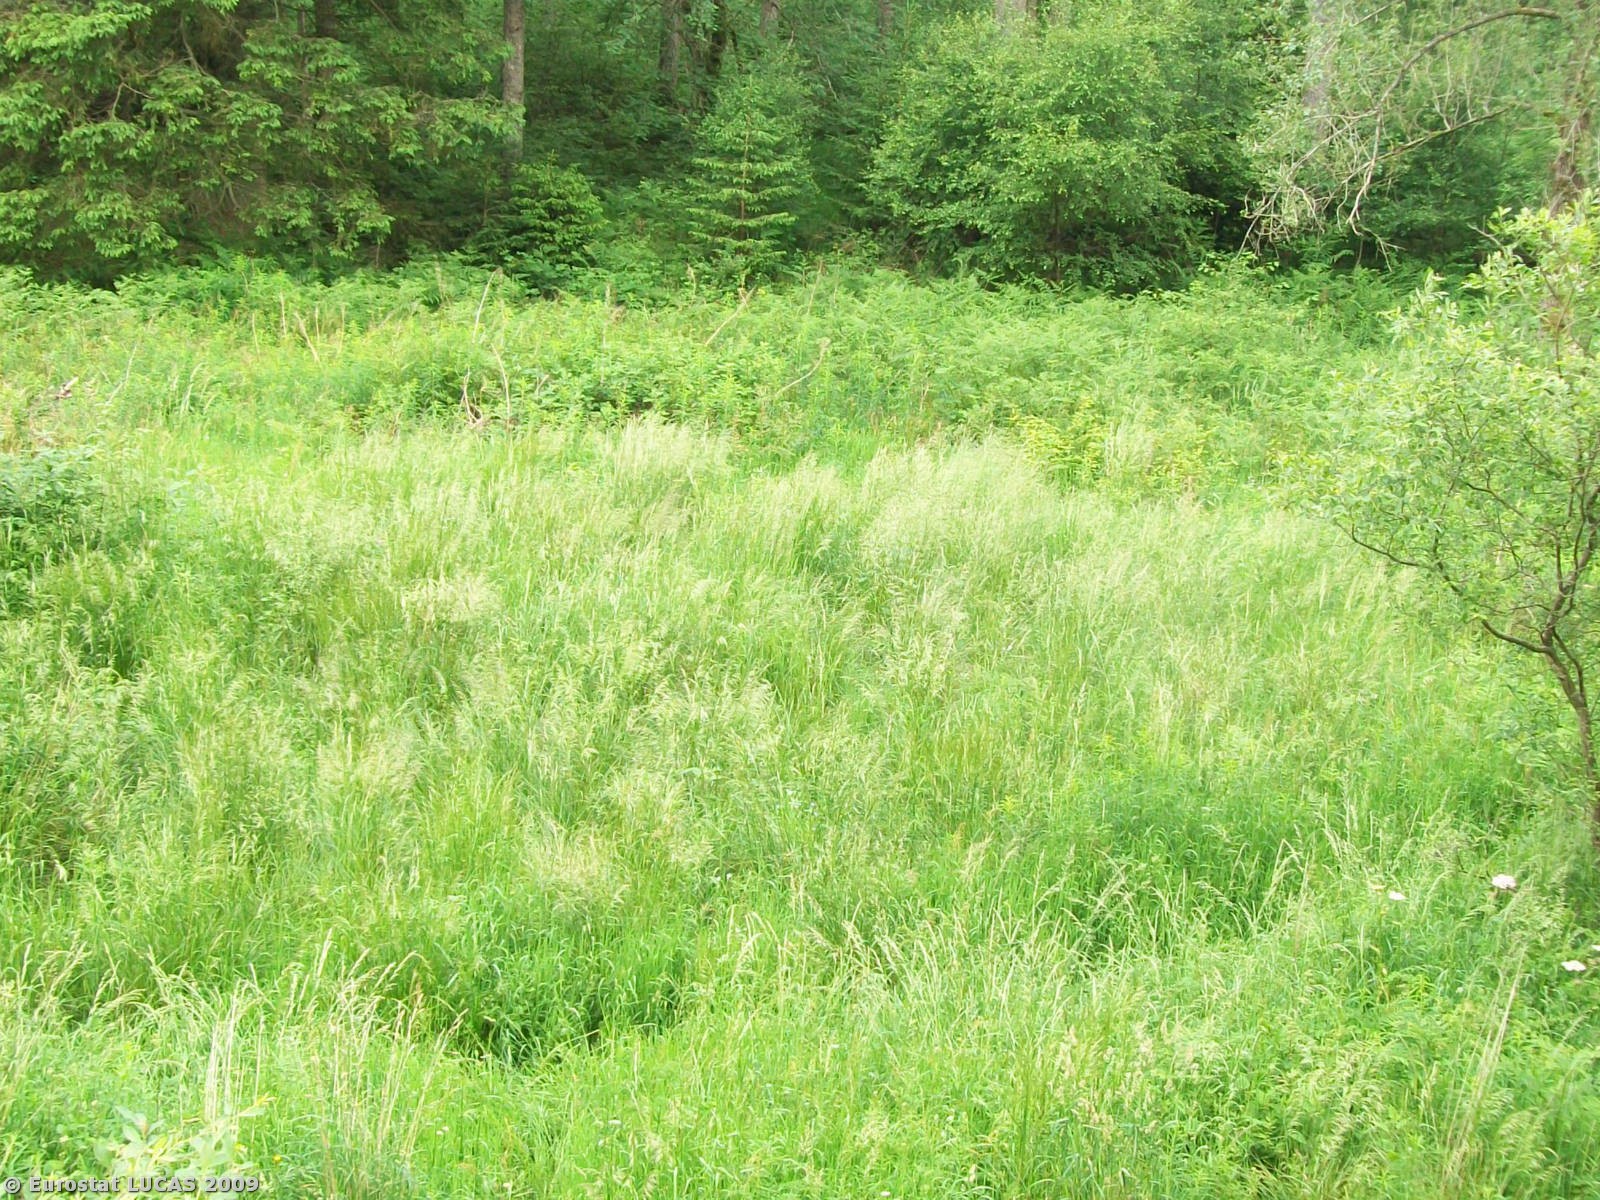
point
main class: Grassland
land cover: Grassland with sparse tree/shrub cover
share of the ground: 50 - 75 %
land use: Forestry
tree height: > 5 m
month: June
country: GB
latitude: 53.0501
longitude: -3.4343
